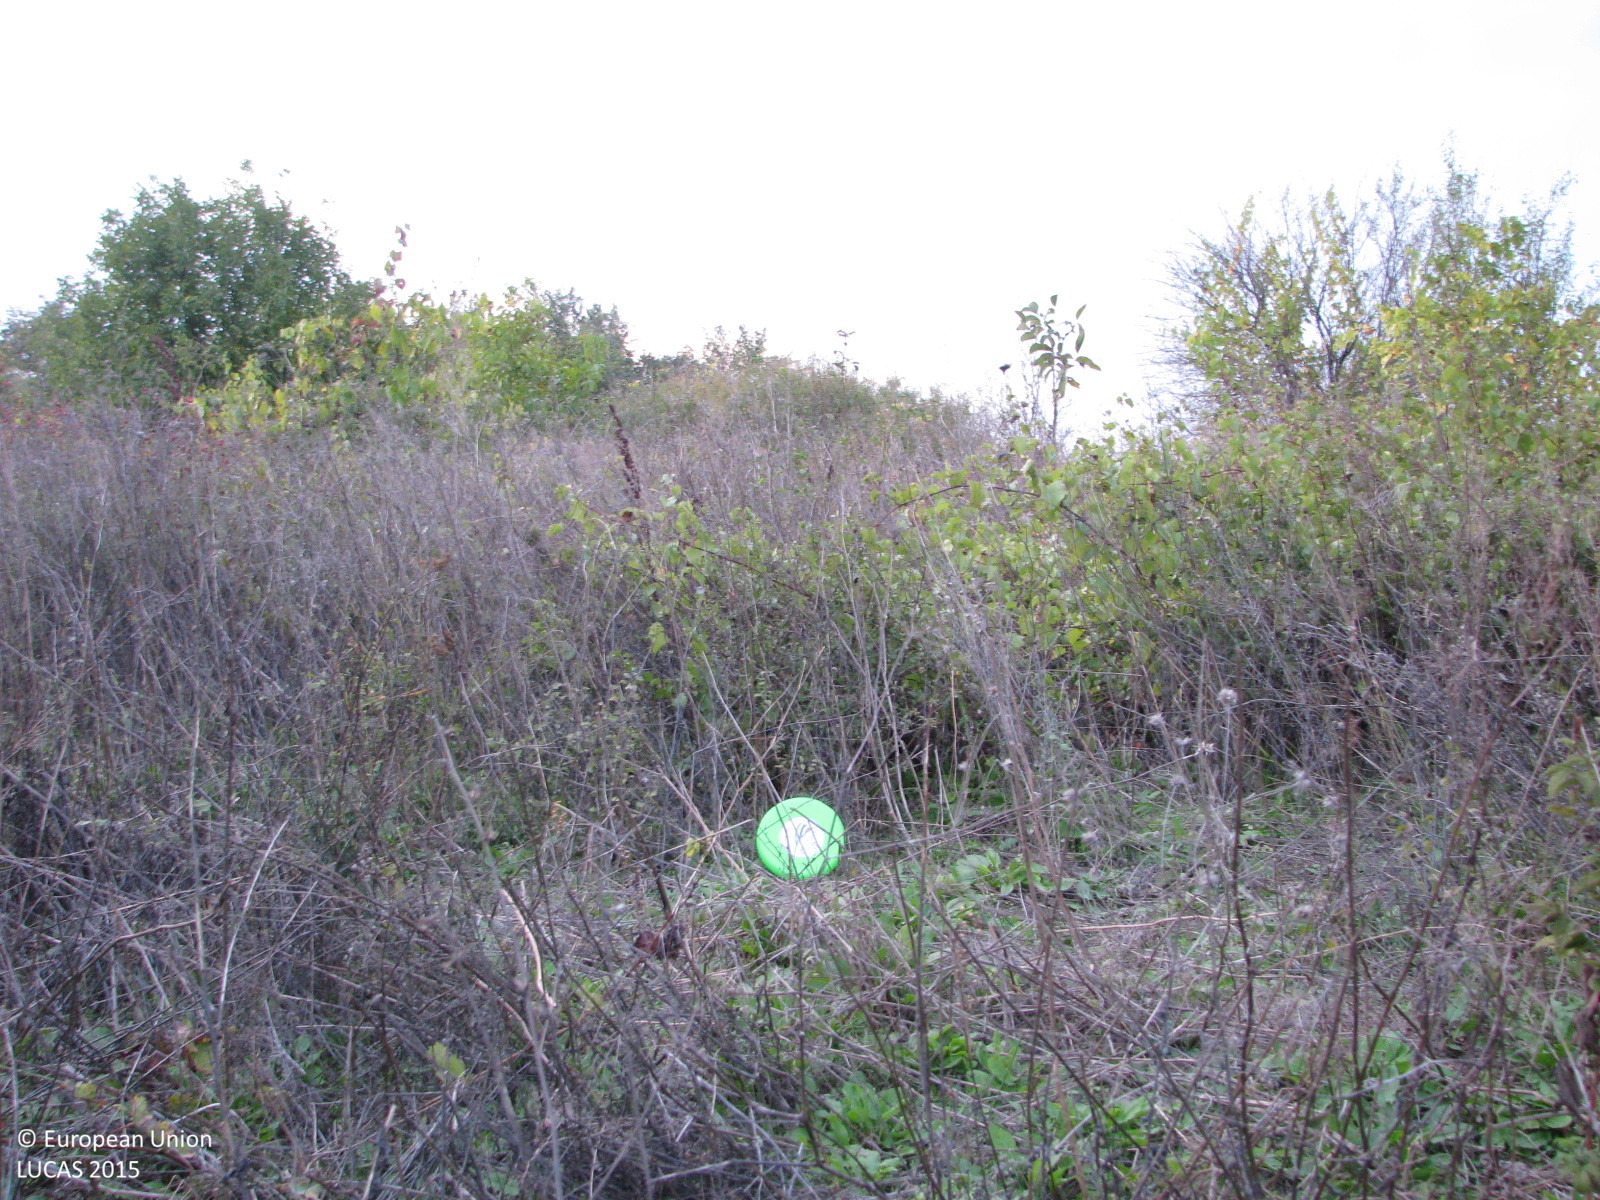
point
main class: Shrubland
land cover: Shrubland with sparse tree cover
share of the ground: 50 - 75 %
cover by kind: shrubs 60 %, herbaceous plants 35 %, broadleaved forest trees 5 %
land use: Semi-natural and natural areas not in use
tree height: < 5 m
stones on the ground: < 10 %
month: October
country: BG
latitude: 42.2524
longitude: 26.4634
